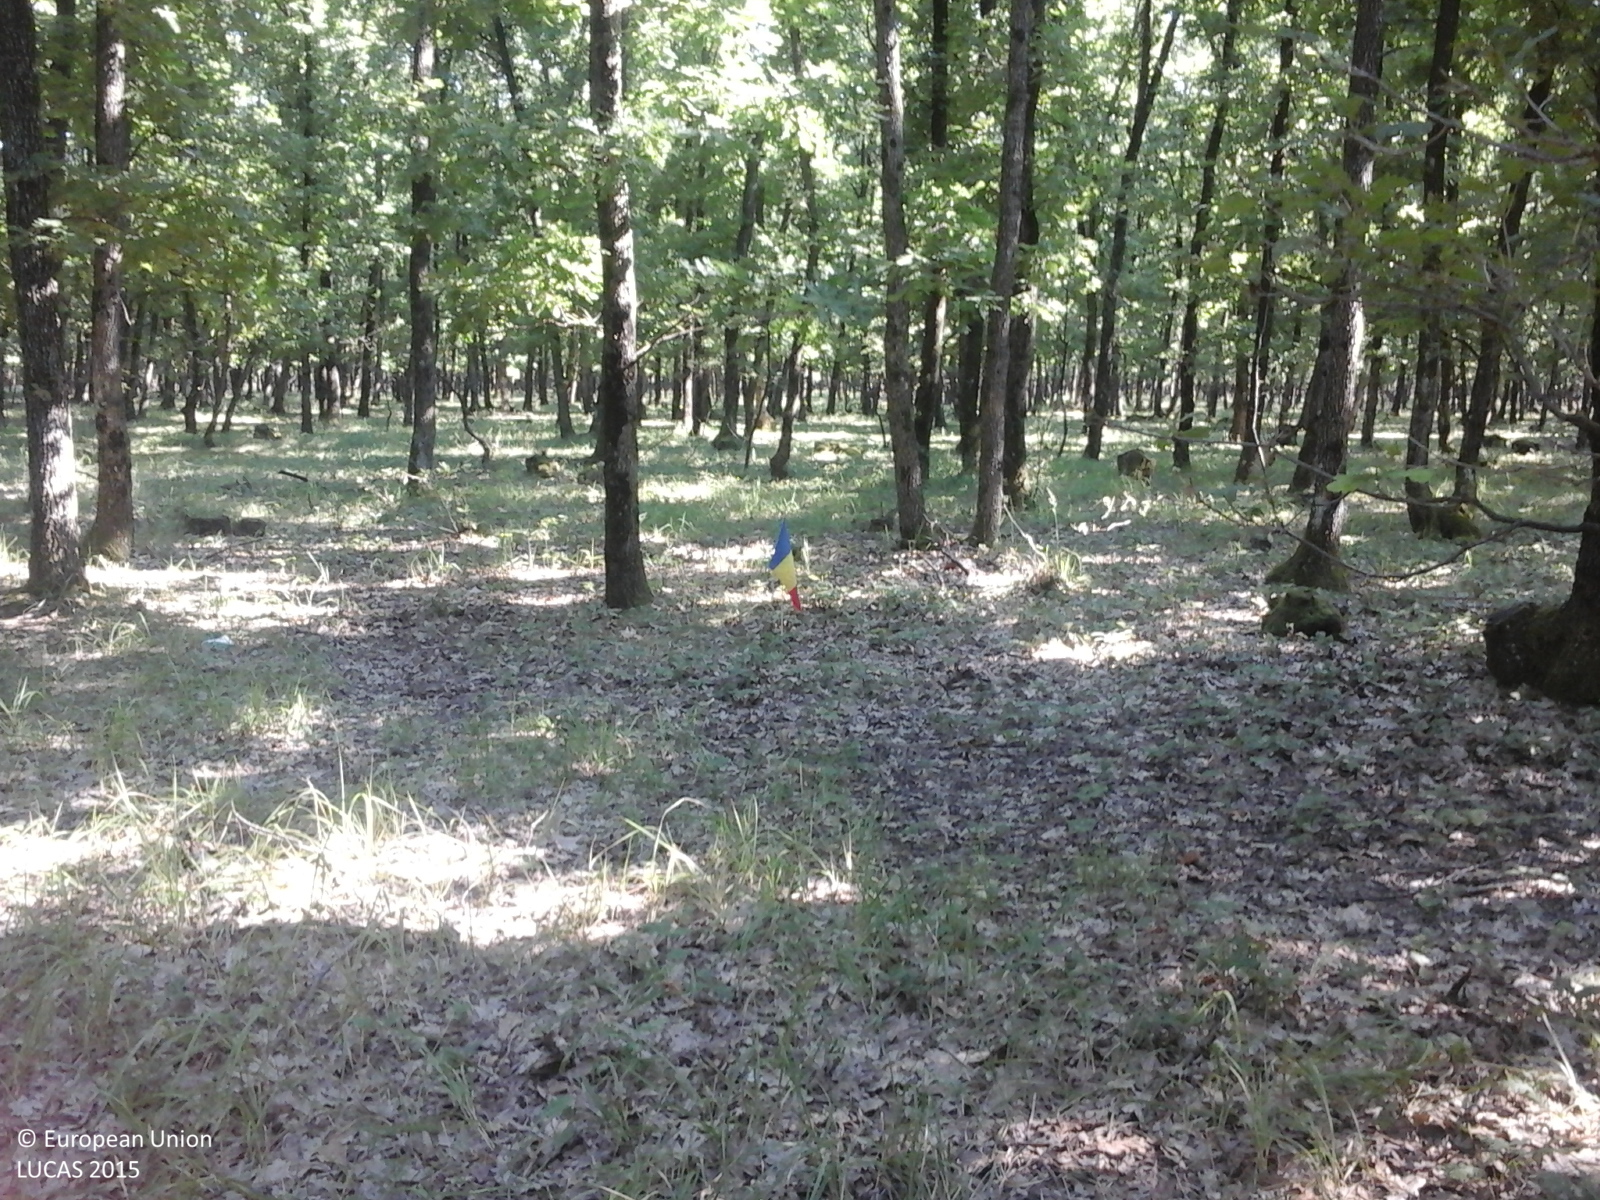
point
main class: Woodland
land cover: Broadleaved woodland
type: thermophilous deciduous forest
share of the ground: > 75 %
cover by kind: broadleaved forest trees 95 %, herbaceous plants 5 %
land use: Forestry
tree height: > 5 m
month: July
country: RO
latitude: 44.5820
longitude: 24.4155
